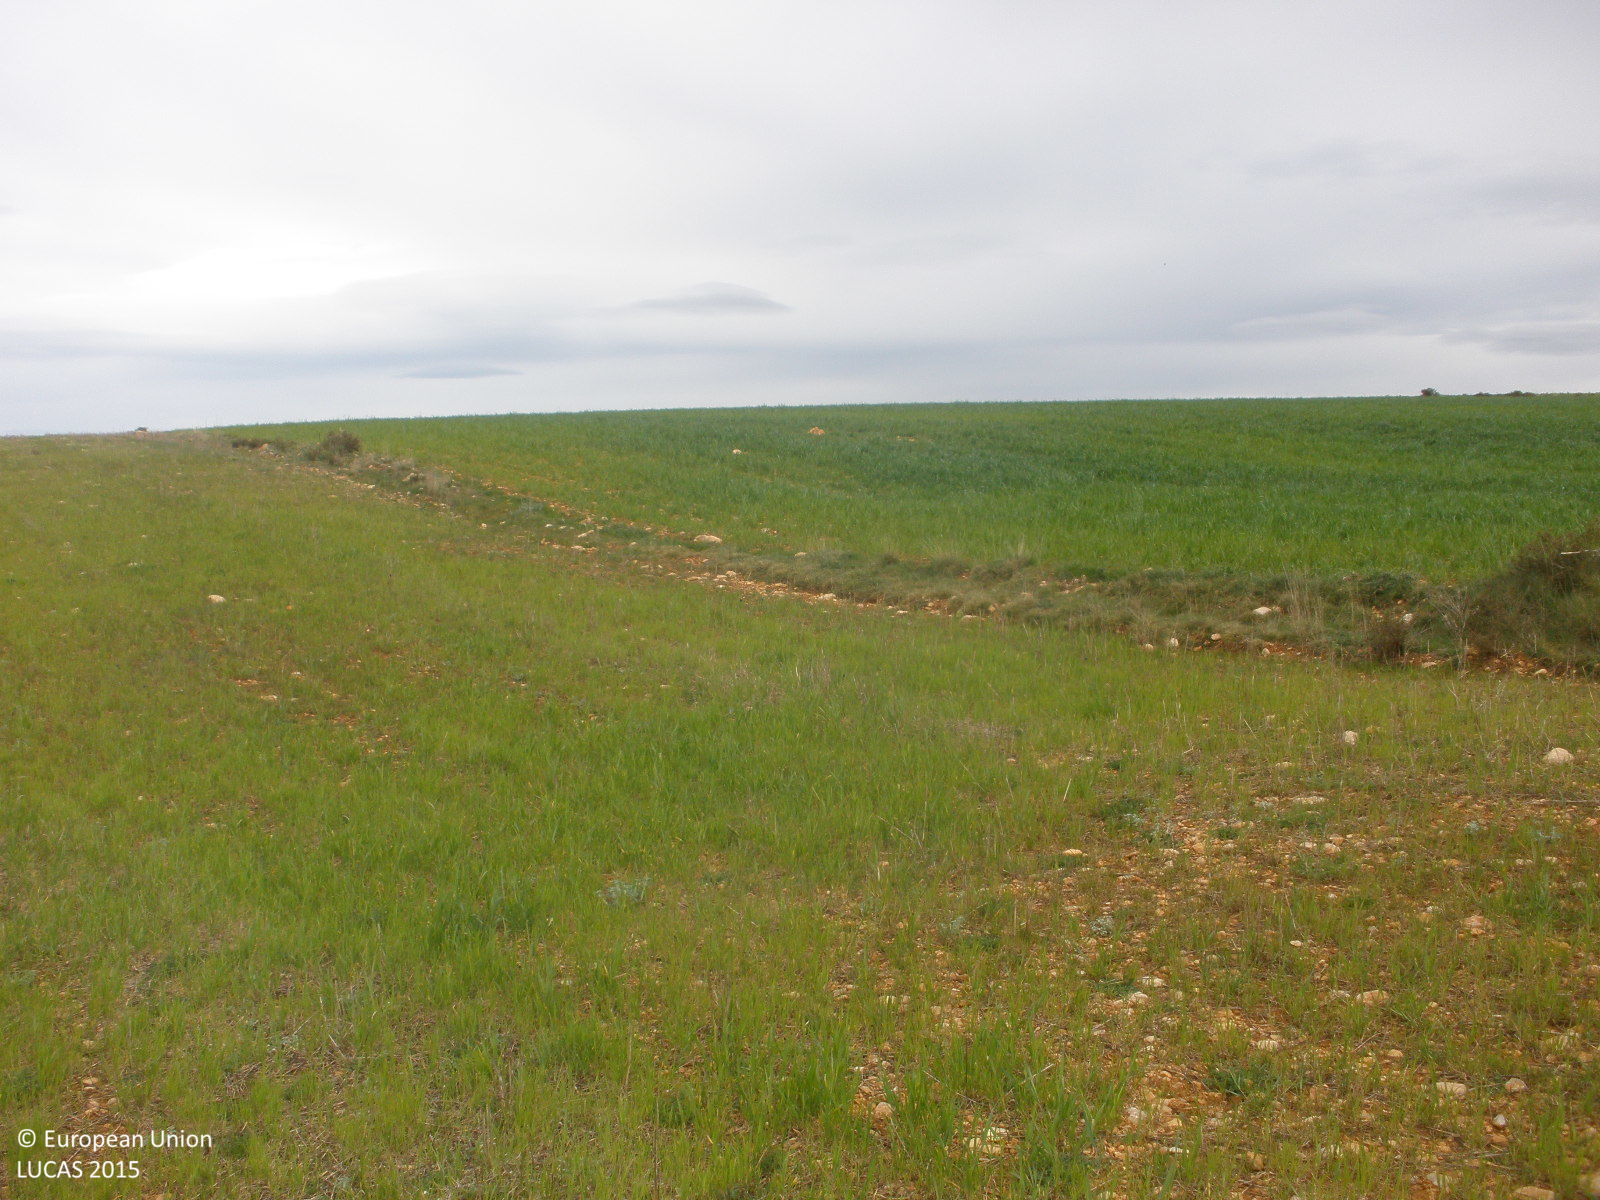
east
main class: Grassland
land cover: Spontaneously vegetated surfaces
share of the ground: > 75 %
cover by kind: herbaceous plants 80 %, consolidated bare surface 20 %
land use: Agriculture (excluding fallow land and kitchen gardens)
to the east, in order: Spontaneously vegetated surfaces; Grass margins; Rye; Grass margins; Tracks; Grass margins; Common wheat
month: May
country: ES
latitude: 40.5277
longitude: -0.7880
